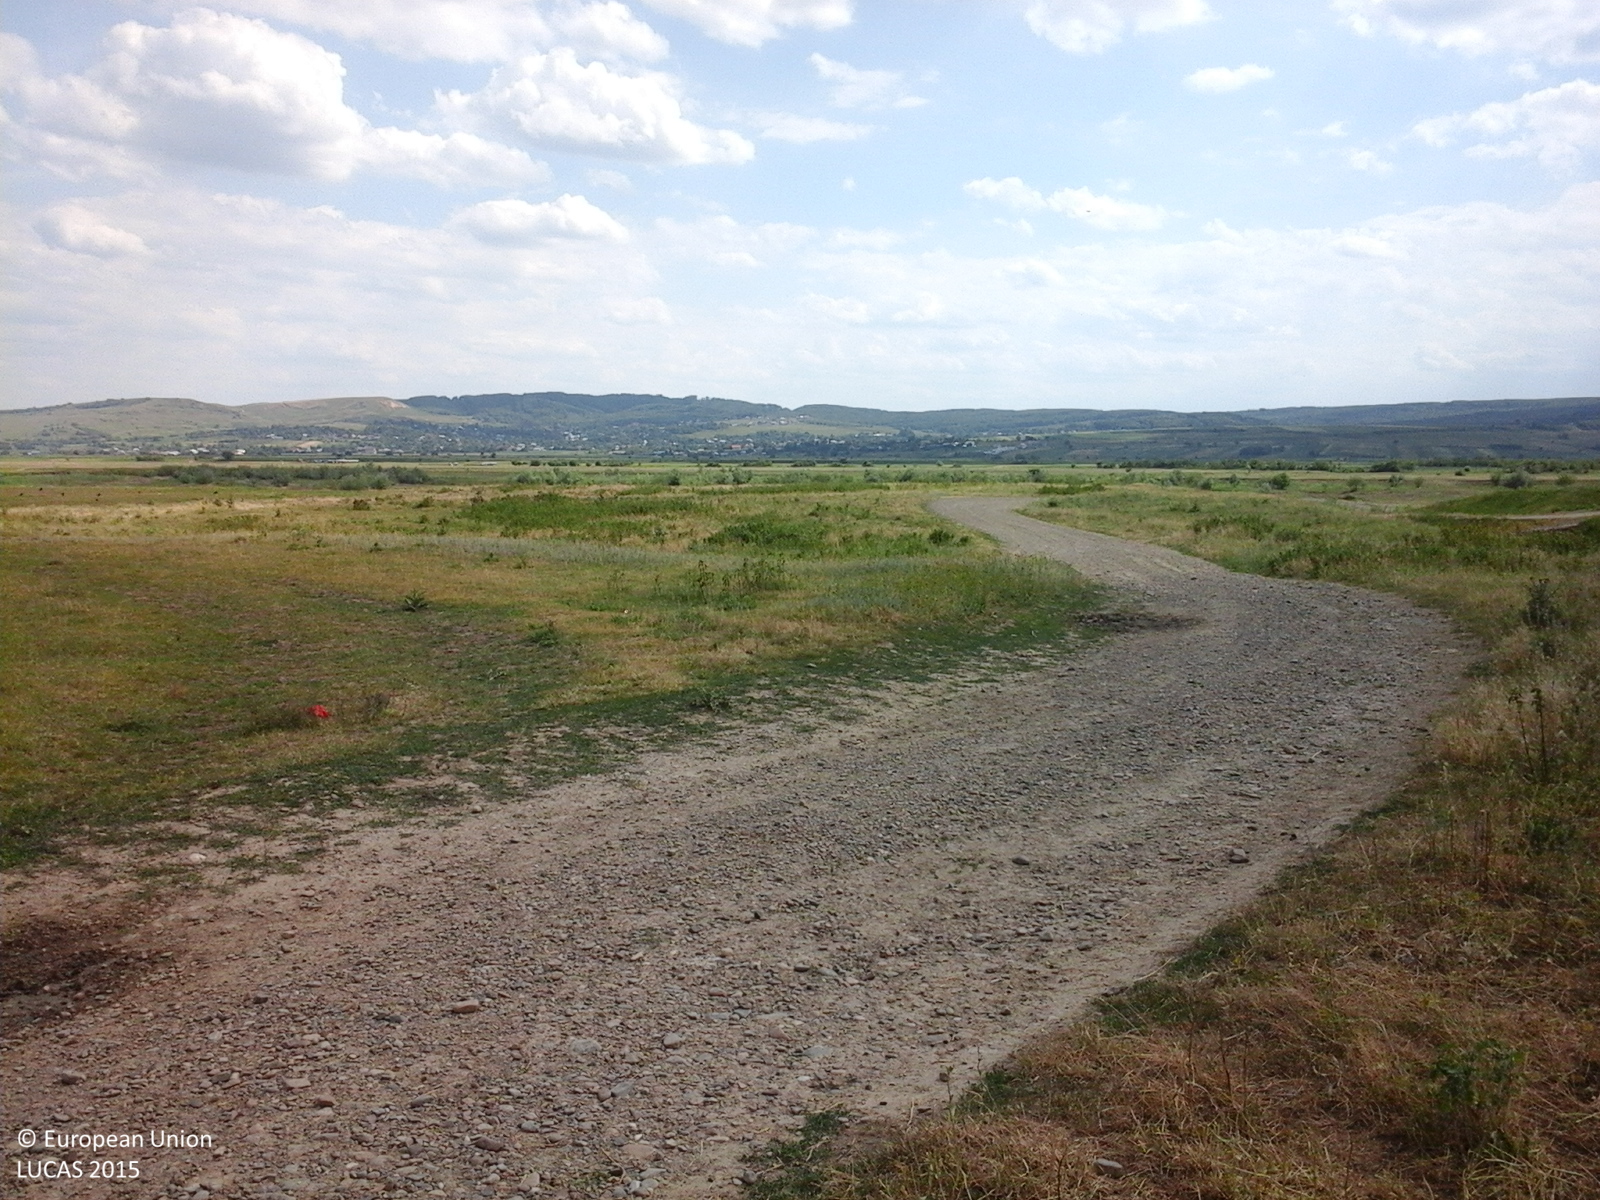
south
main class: Grassland
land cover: Spontaneously vegetated surfaces
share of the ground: > 75 %
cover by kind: herbaceous plants 100 %
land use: Agriculture (excluding fallow land and kitchen gardens)
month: June
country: RO
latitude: 47.6071
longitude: 26.4089
